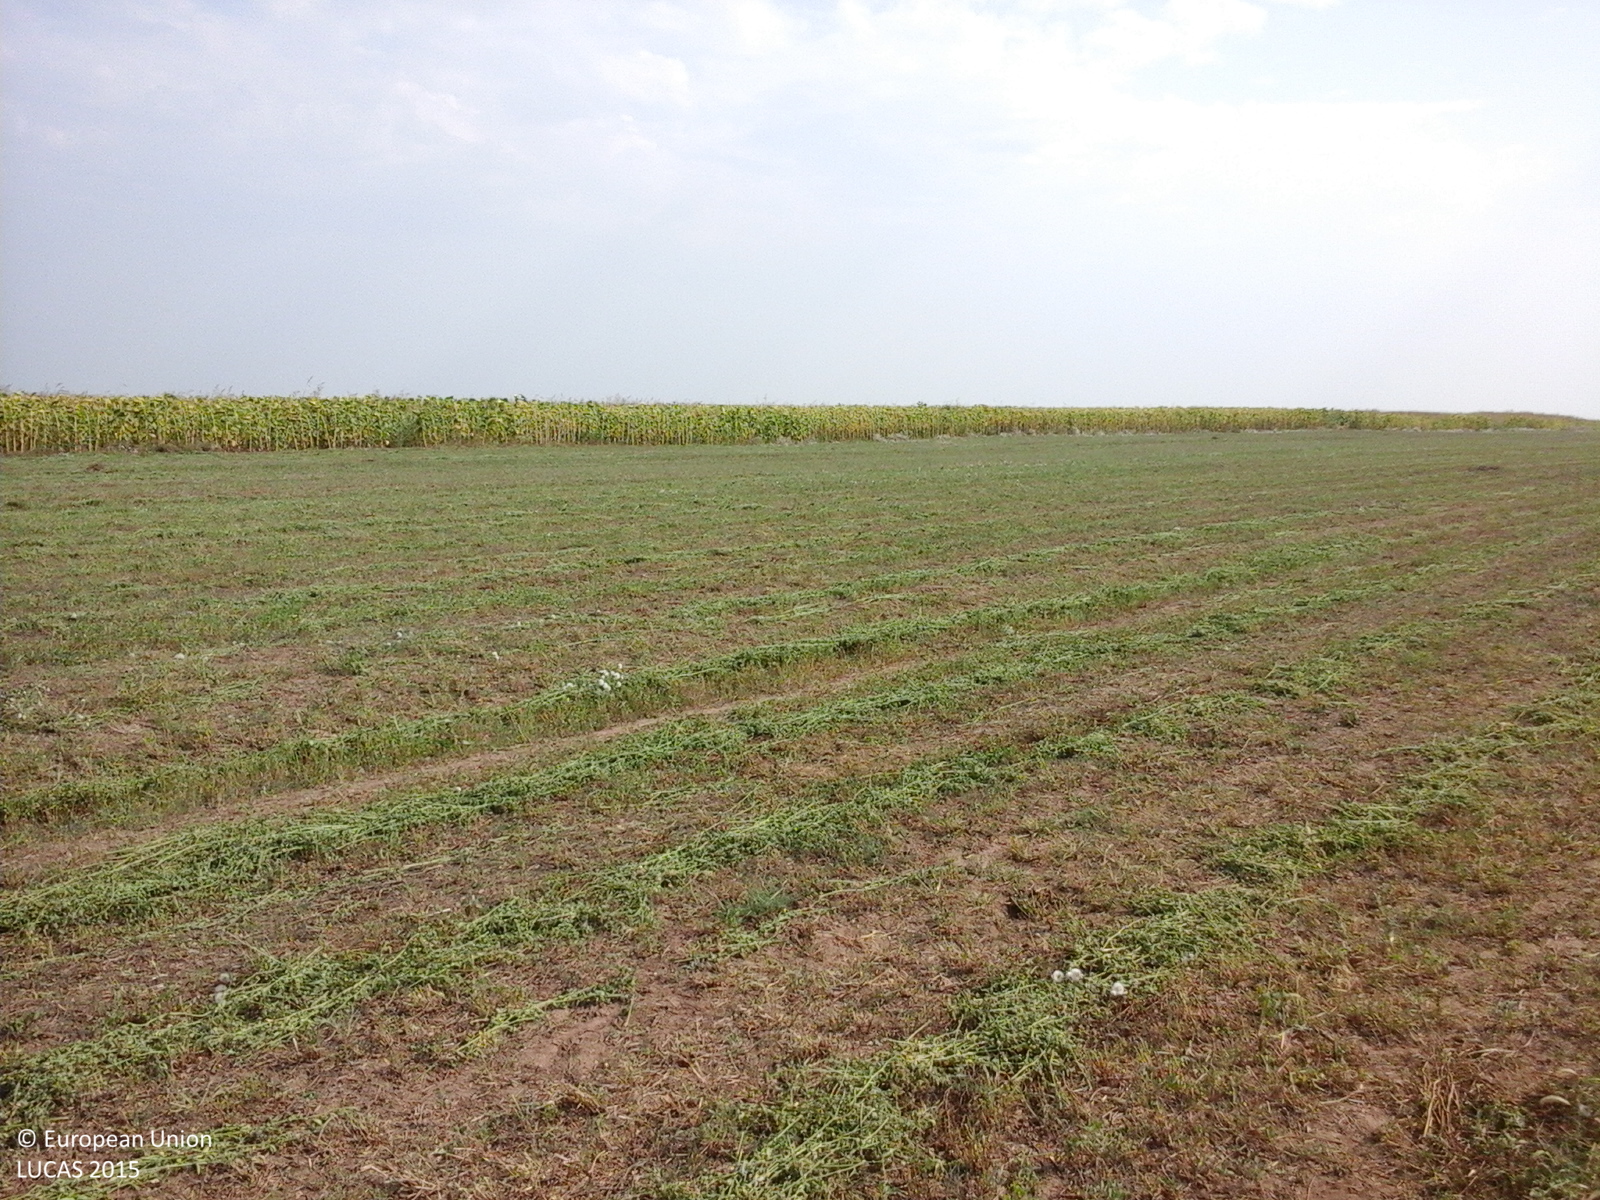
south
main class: Cropland
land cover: Lucerne
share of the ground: 50 - 75 %
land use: Agriculture (excluding fallow land and kitchen gardens)
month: August
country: RO
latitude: 45.2846
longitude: 27.4767
